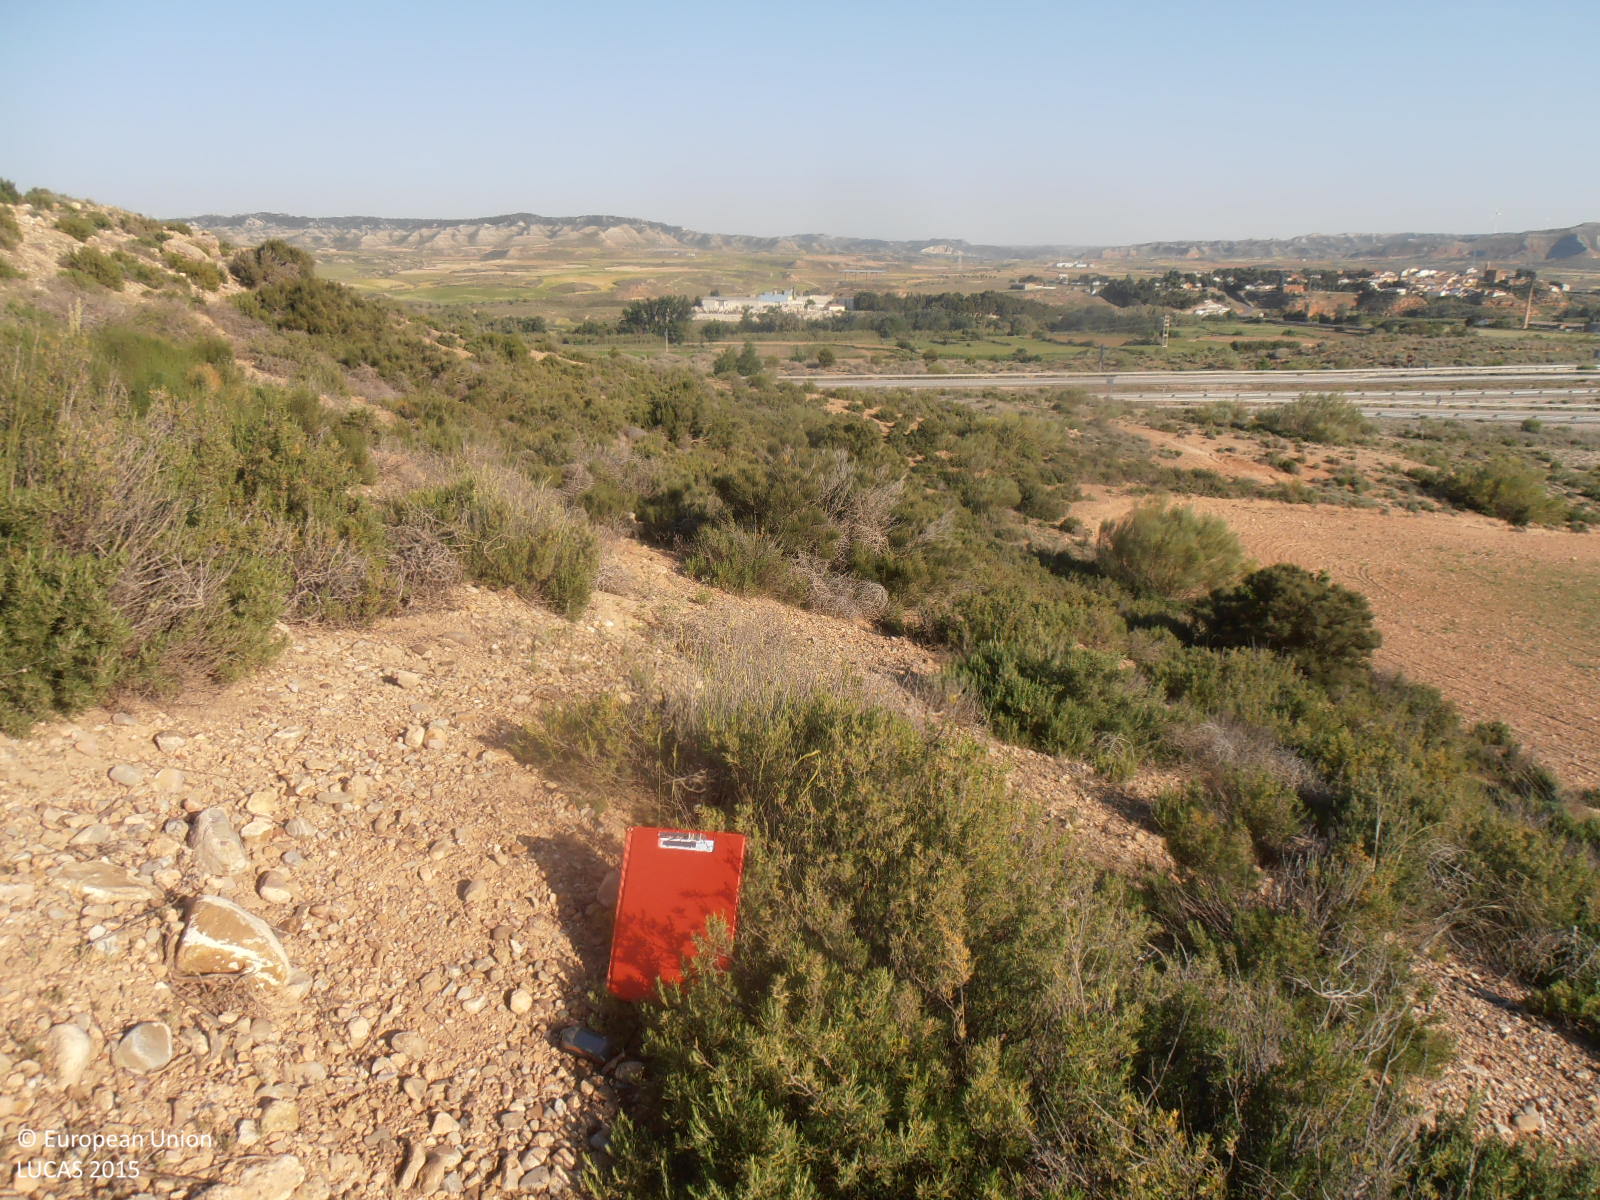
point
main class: Shrubland
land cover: Shrubland without tree cover
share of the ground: 25 - 50 %
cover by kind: consolidated bare surface 50 %, shrubs 40 %, unconsolidated bare surface 10 %
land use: Semi-natural and natural areas not in use
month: May
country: ES
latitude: 41.5210
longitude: -1.0344
